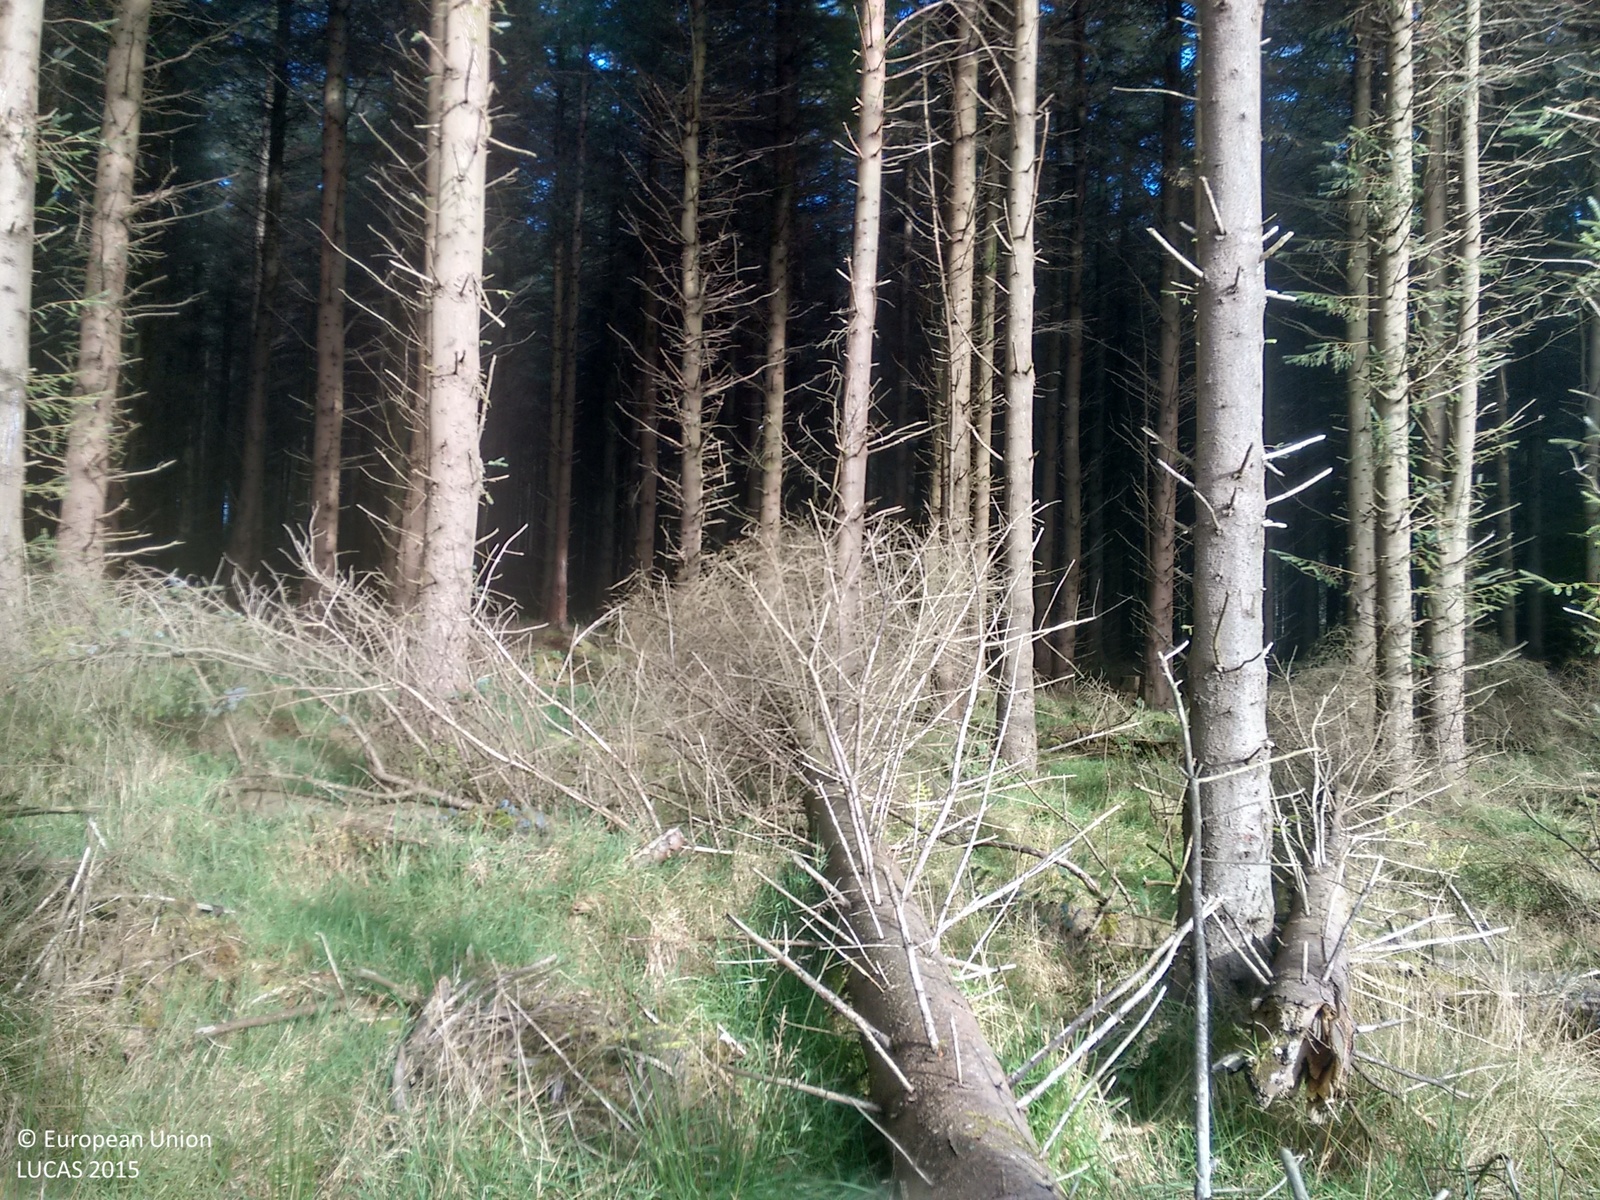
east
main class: Woodland
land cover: Spruce dominated coniferous woodland
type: exotic forest
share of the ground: > 75 %
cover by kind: coniferous forest trees 65 %, herbaceous plants 35 %
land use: Forestry
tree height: > 5 m
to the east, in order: Spruce dominated coniferous woodland; Spontaneously vegetated surfaces
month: October
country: IE
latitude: 52.9905
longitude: -7.6686
